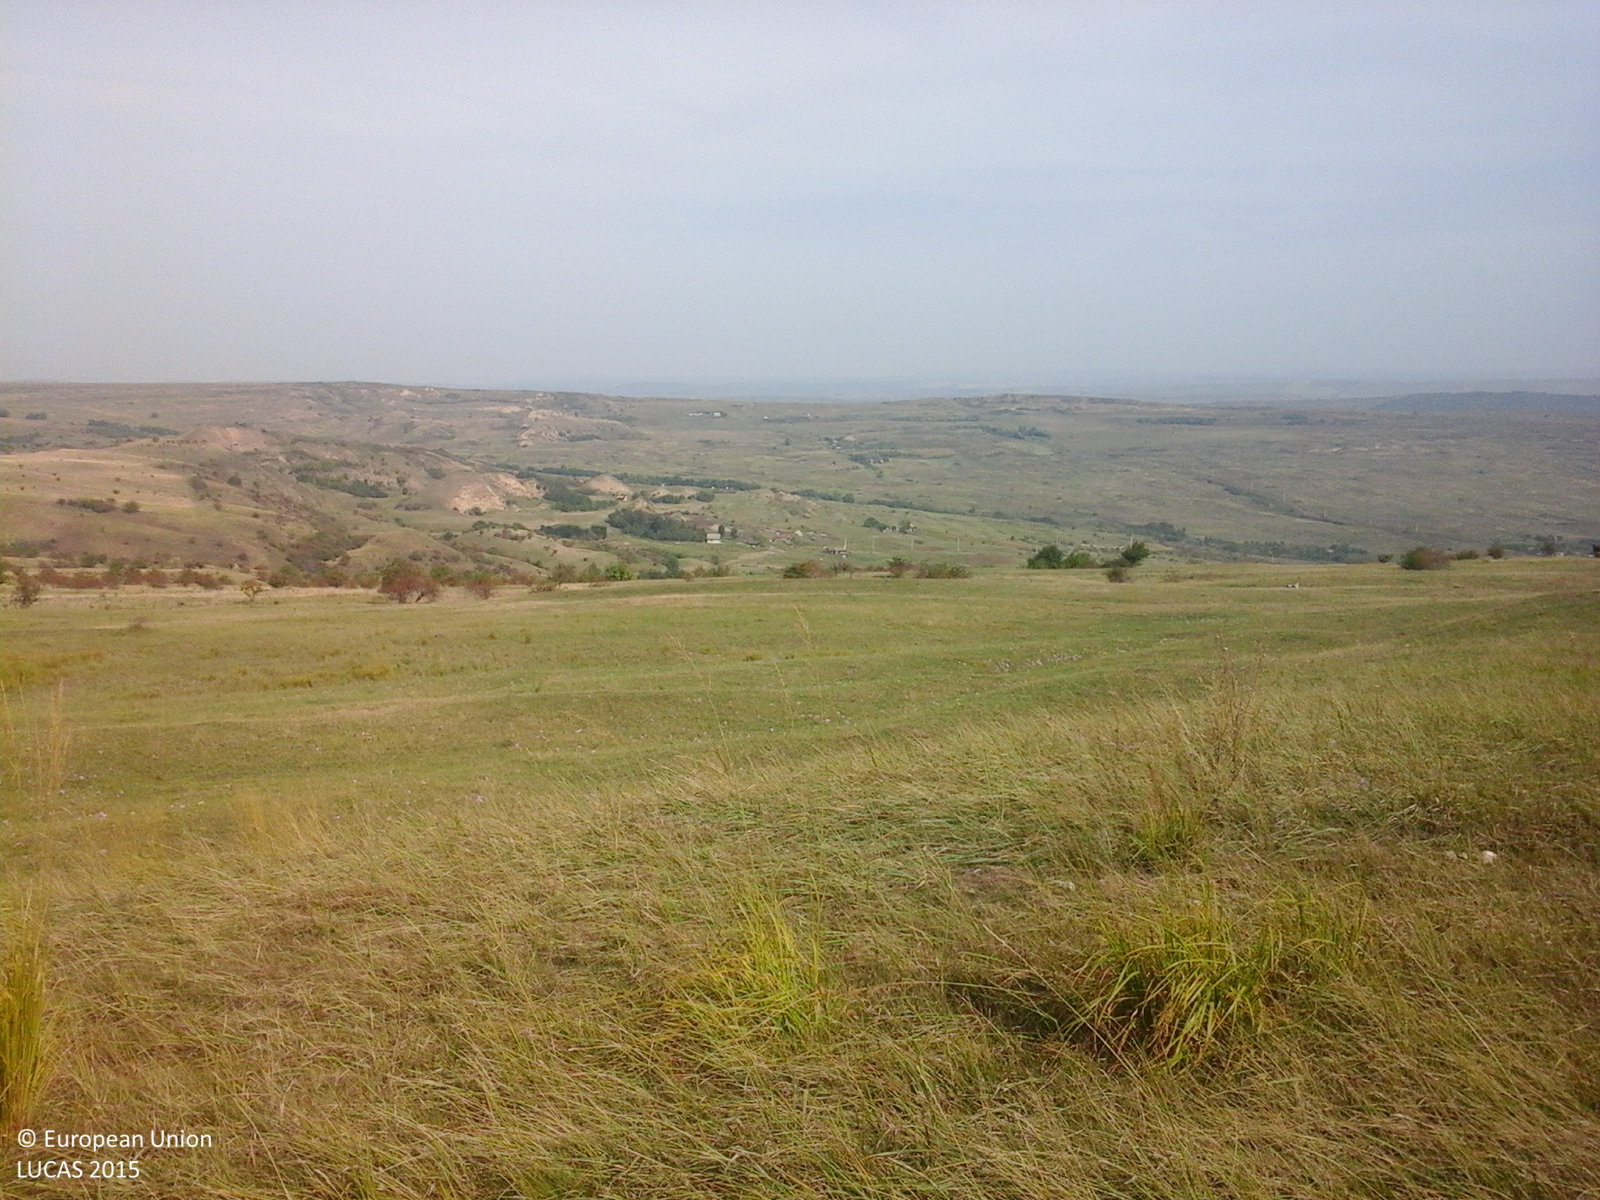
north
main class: Grassland
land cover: Grassland without tree/shrub cover
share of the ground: > 75 %
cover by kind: herbaceous plants 100 %
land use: Agriculture (excluding fallow land and kitchen gardens)
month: September
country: RO
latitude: 46.8411
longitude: 23.6438
